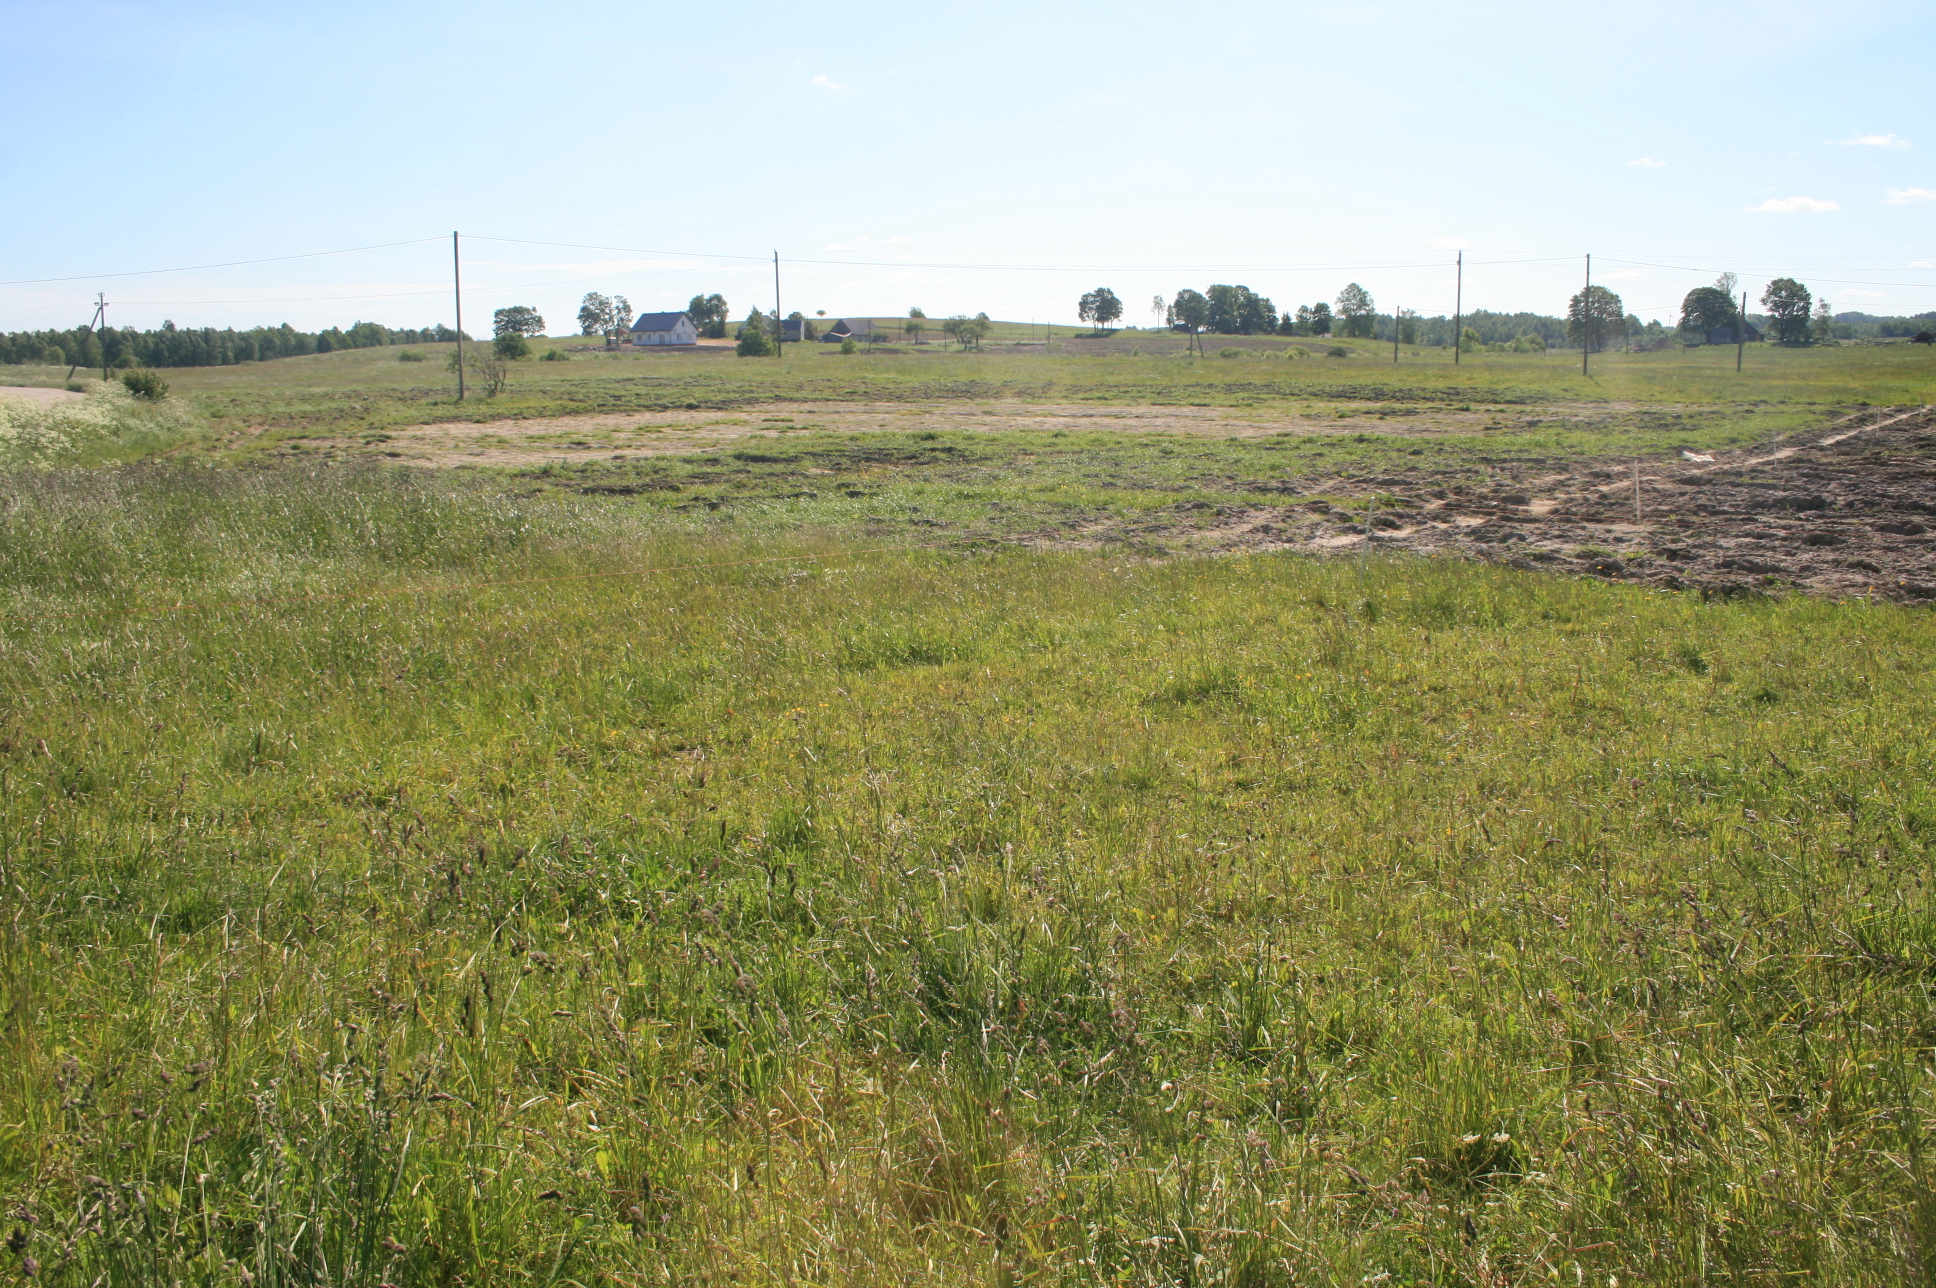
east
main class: Grassland
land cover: Grassland without tree/shrub cover
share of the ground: > 75 %
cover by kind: herbaceous plants 100 %
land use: Agriculture (excluding fallow land and kitchen gardens)
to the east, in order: Grassland without tree/shrub cover; Electric lines; Grassland without tree/shrub cover; Electric lines; Grassland without tree/shrub cover; Paved roads, cycling and walking lanes
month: June
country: LT
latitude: 55.9420
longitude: 22.2719
